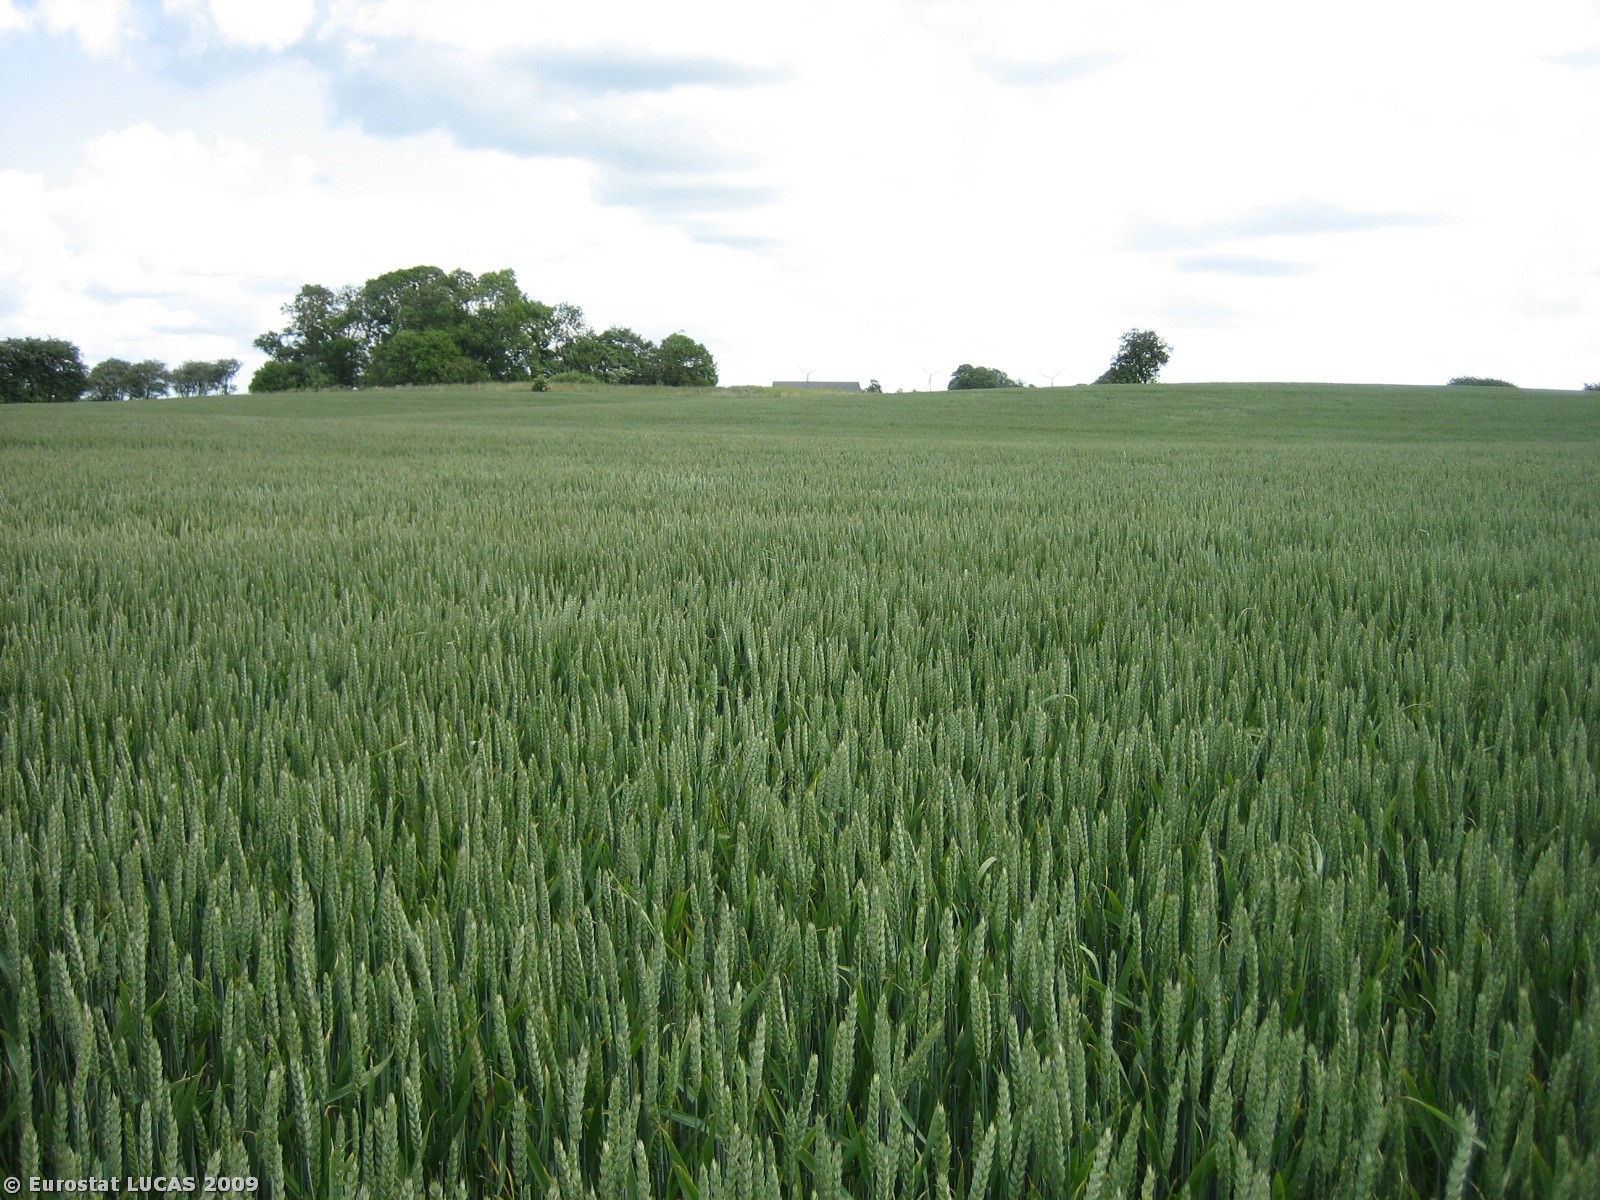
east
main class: Cropland
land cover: Common wheat
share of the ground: > 75 %
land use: Agriculture (excluding fallow land and kitchen gardens)
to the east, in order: Common wheat; Fences; Grass margins; Arable land (only in case pi)
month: June
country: DK
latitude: 55.7006
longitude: 9.3165
